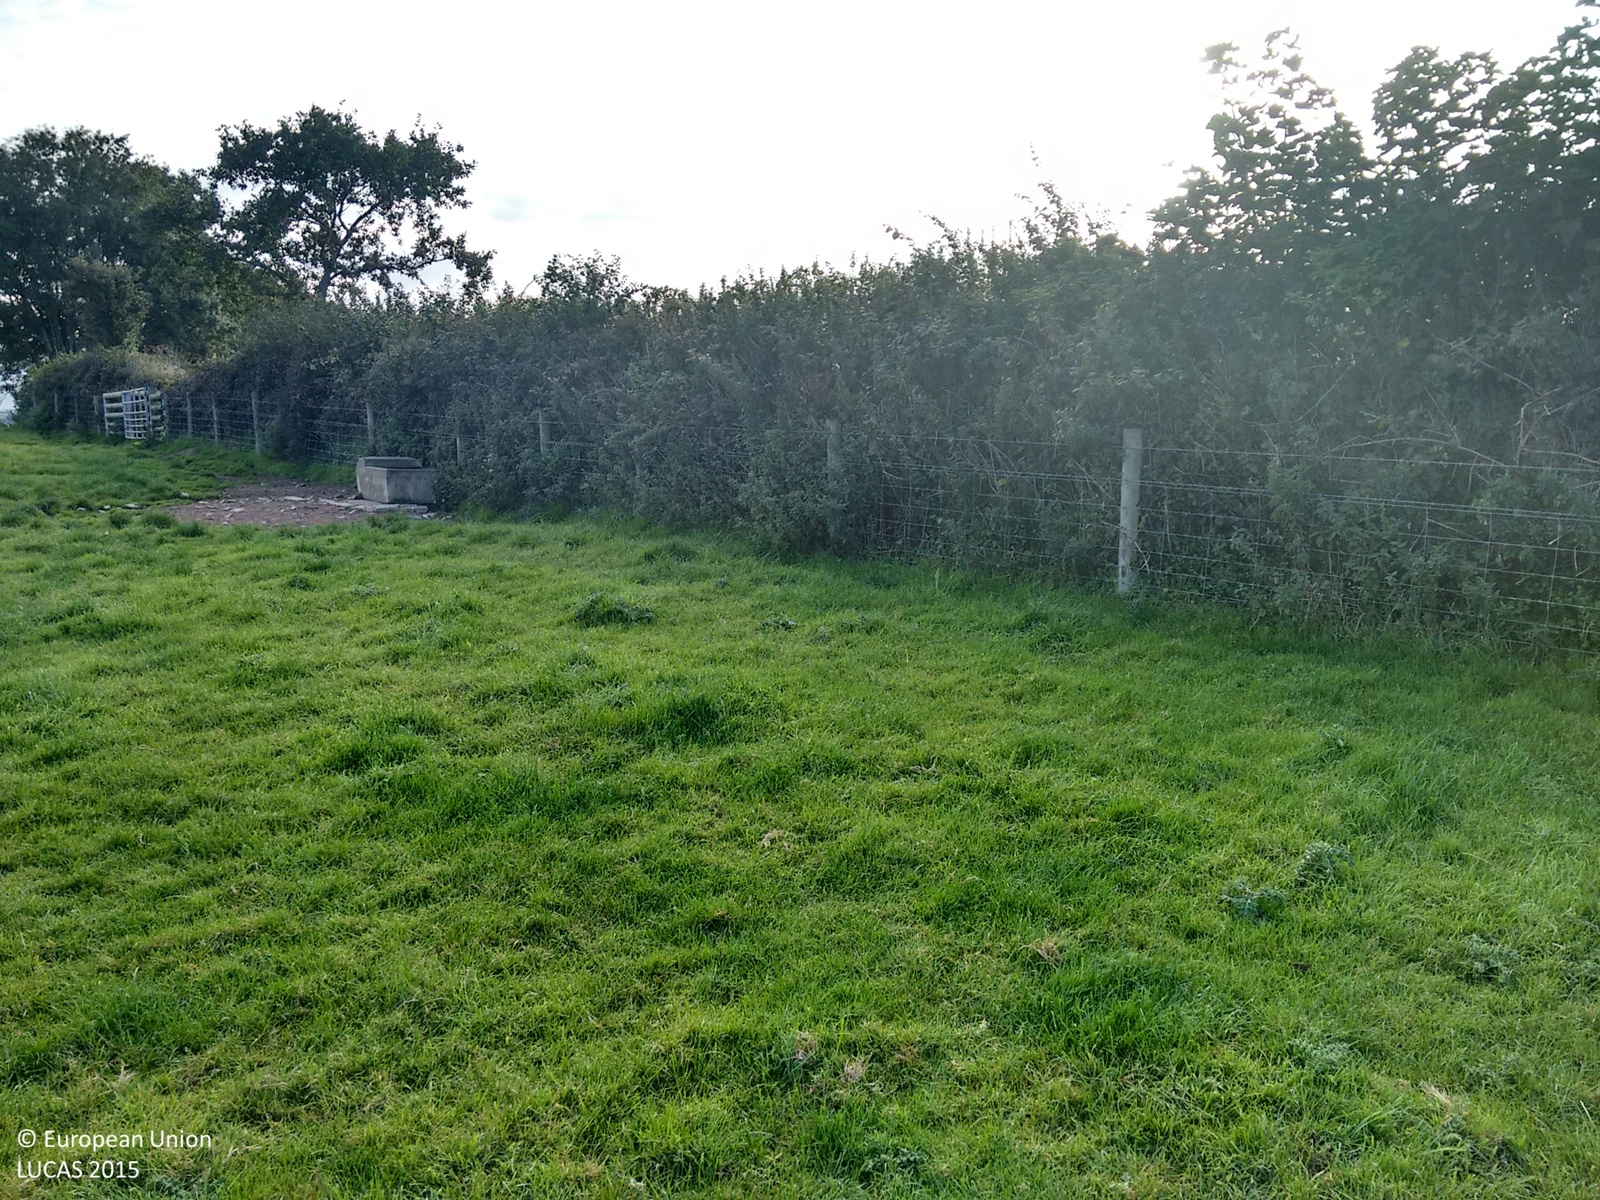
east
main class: Grassland
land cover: Grassland without tree/shrub cover
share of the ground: > 75 %
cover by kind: herbaceous plants 100 %
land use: Agriculture (excluding fallow land and kitchen gardens)
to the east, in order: Grassland without tree/shrub cover; Fences; Managed hedges; Fences; Grassland without tree/shrub cover; Electric lines; Grassland without tree/shrub cover; Fences; Managed hedges; Fences; Grassland without tree/shrub cover
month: September
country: GB
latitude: 50.6417
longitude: -4.3409
